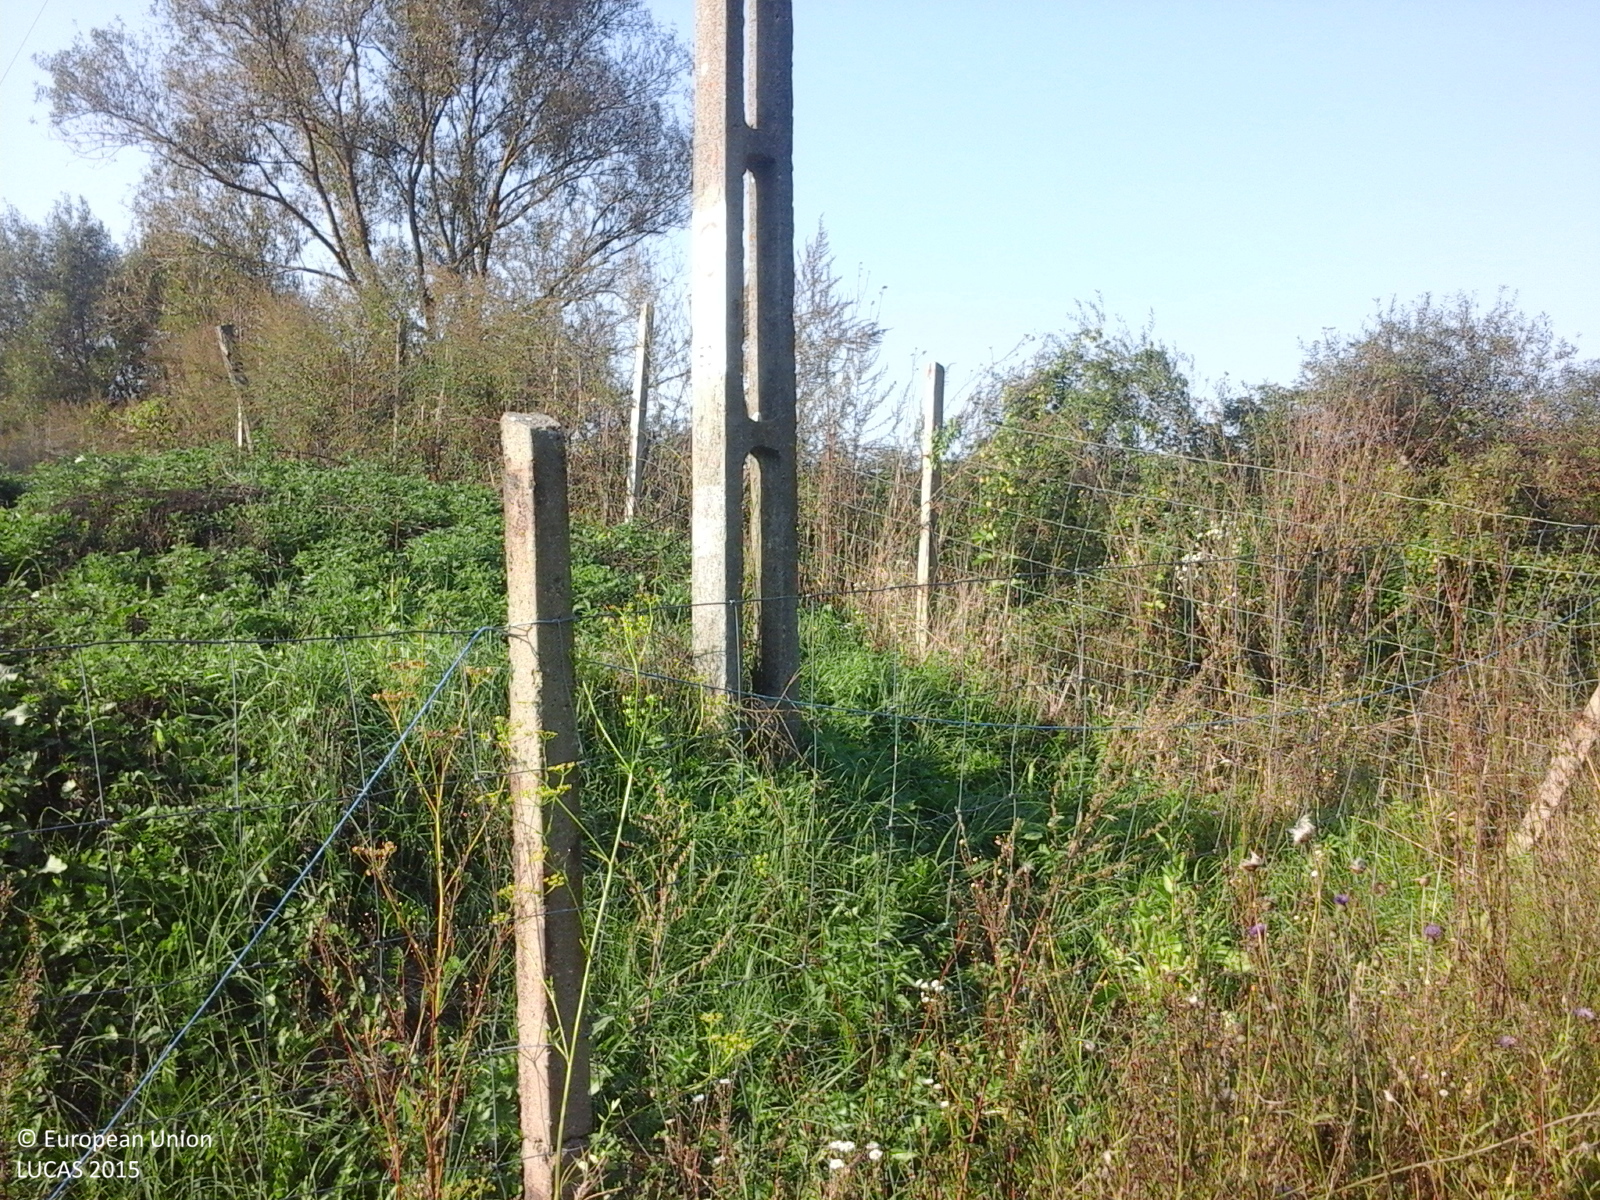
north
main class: Grassland
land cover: Spontaneously vegetated surfaces
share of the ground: > 75 %
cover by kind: herbaceous plants 100 %
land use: Fallow land
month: September
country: RO
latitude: 47.2275
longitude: 22.7248
